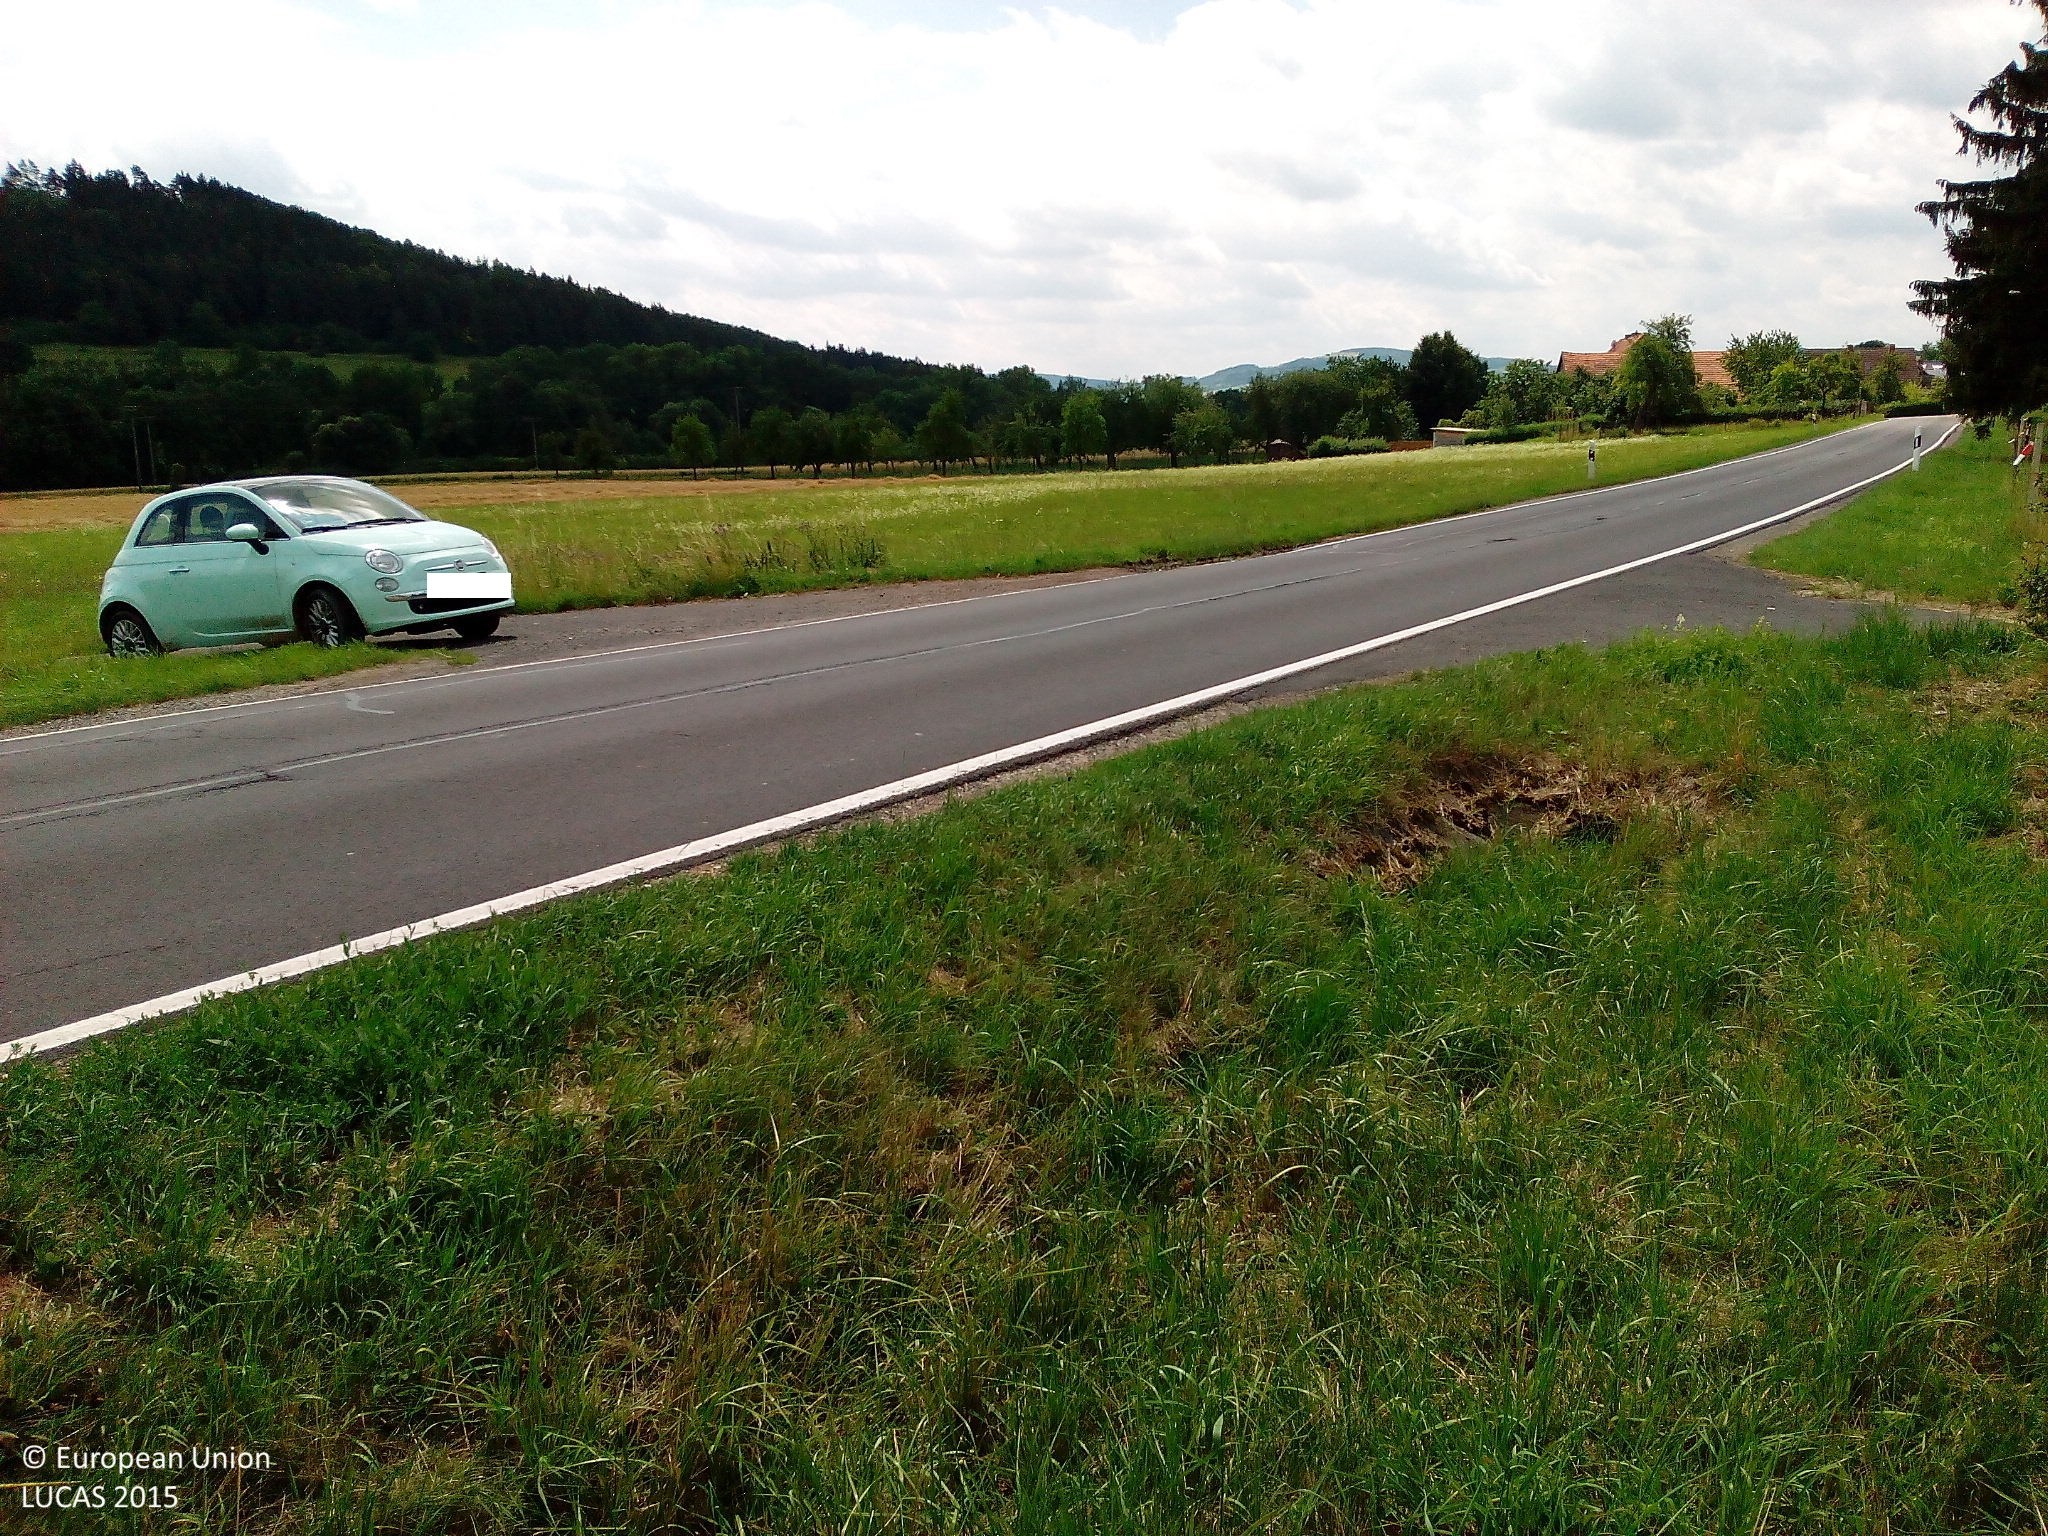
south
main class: Cropland
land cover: Barley
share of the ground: > 75 %
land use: Agriculture (excluding fallow land and kitchen gardens)
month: July
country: DE
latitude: 50.7056
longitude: 9.9292
